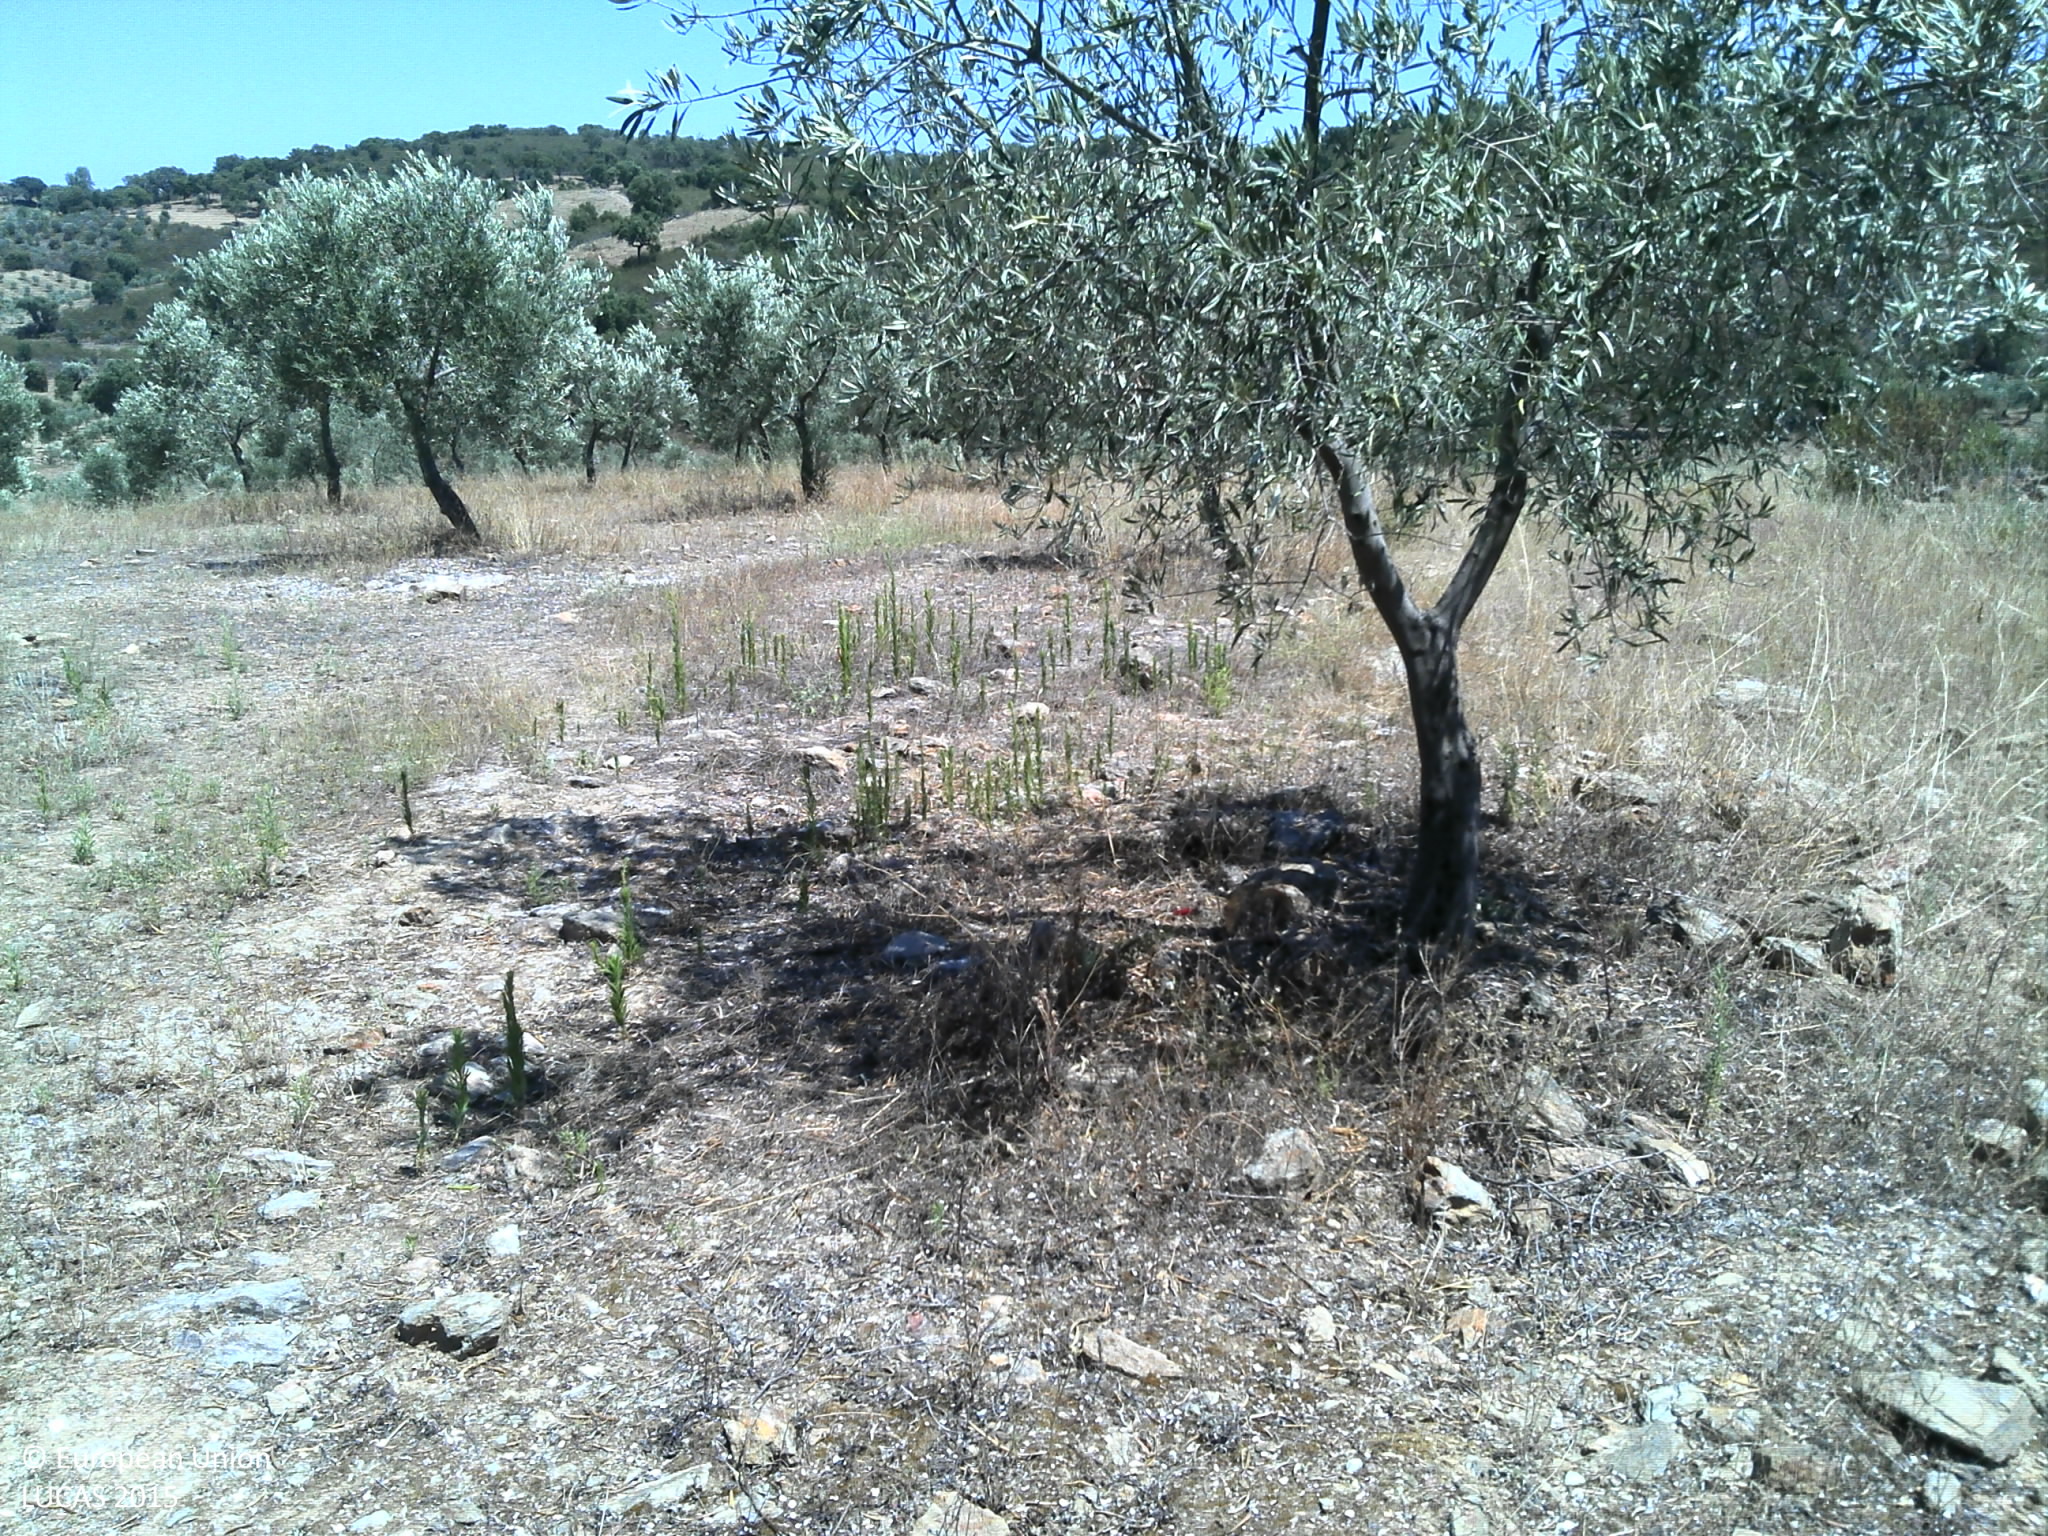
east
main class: Cropland
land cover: Olive groves
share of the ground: 25 - 50 %
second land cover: Grassland without tree/shrub cover
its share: 10 - 25 %
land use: Agriculture (excluding fallow land and kitchen gardens)
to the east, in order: Olive groves; Grassland without tree/shrub cover; Olive groves; Grassland without tree/shrub cover; Dry stone walls; Grassland without tree/shrub cover; Shrubland without tree cover; Broadleaved woodland
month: July
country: PT
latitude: 41.4204
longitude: -7.2410
